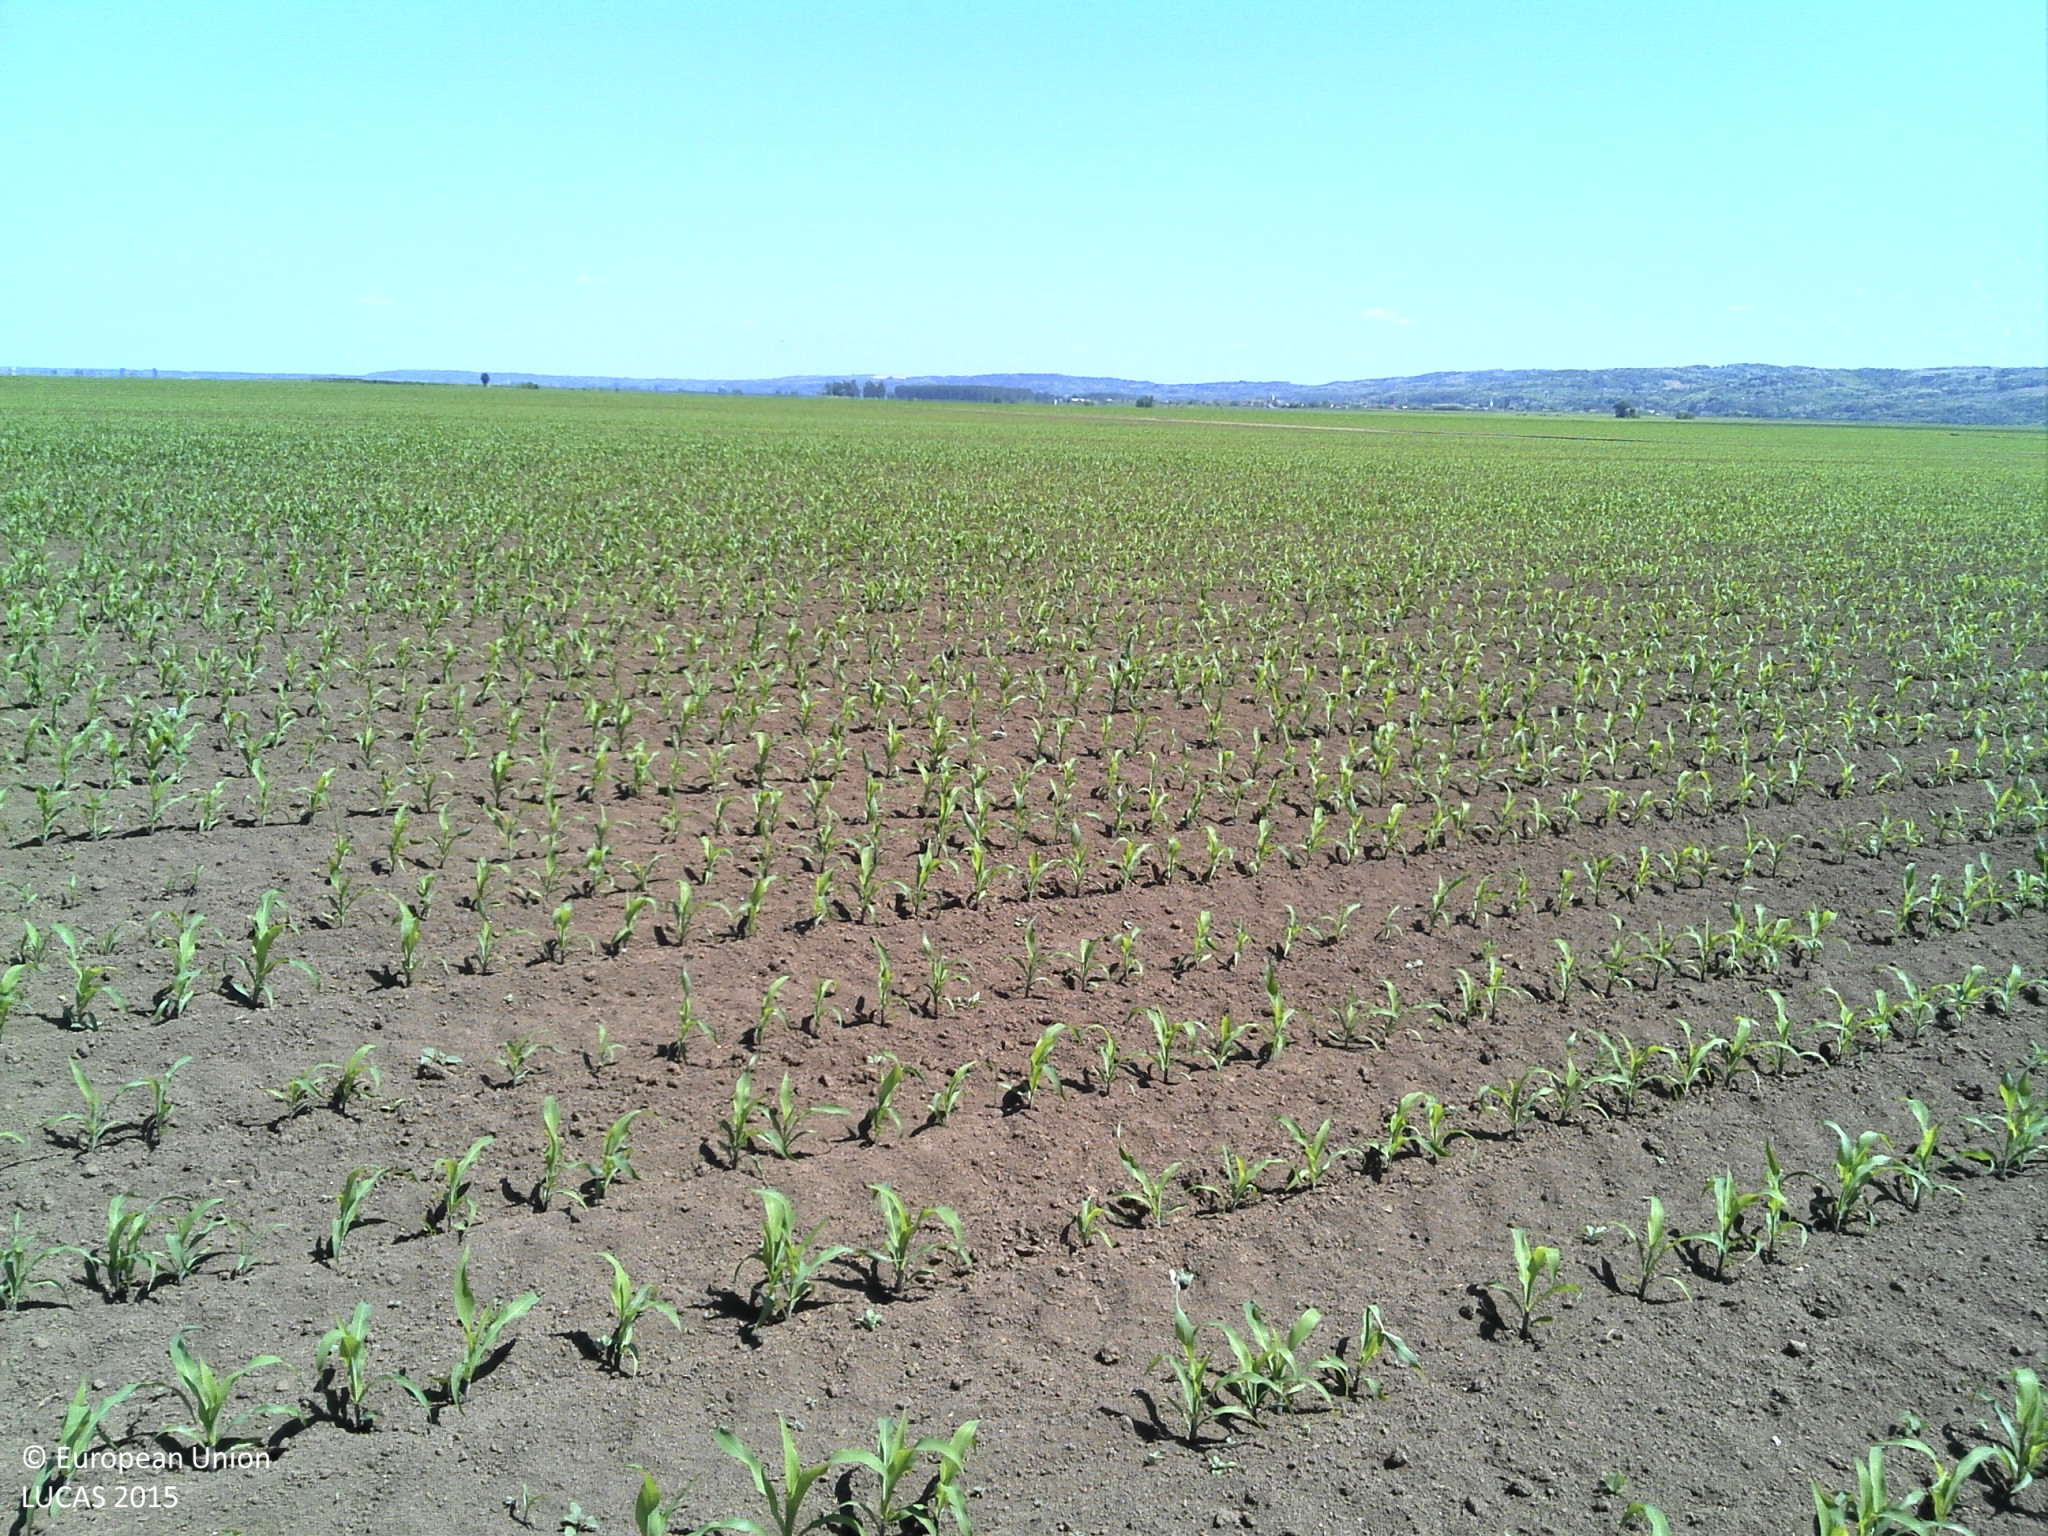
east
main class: Cropland
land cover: Maize
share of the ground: < 10 %
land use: Agriculture (excluding fallow land and kitchen gardens)
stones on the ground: < 10 %
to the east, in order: Maize
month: May
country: HR
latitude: 45.8375
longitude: 18.6476
